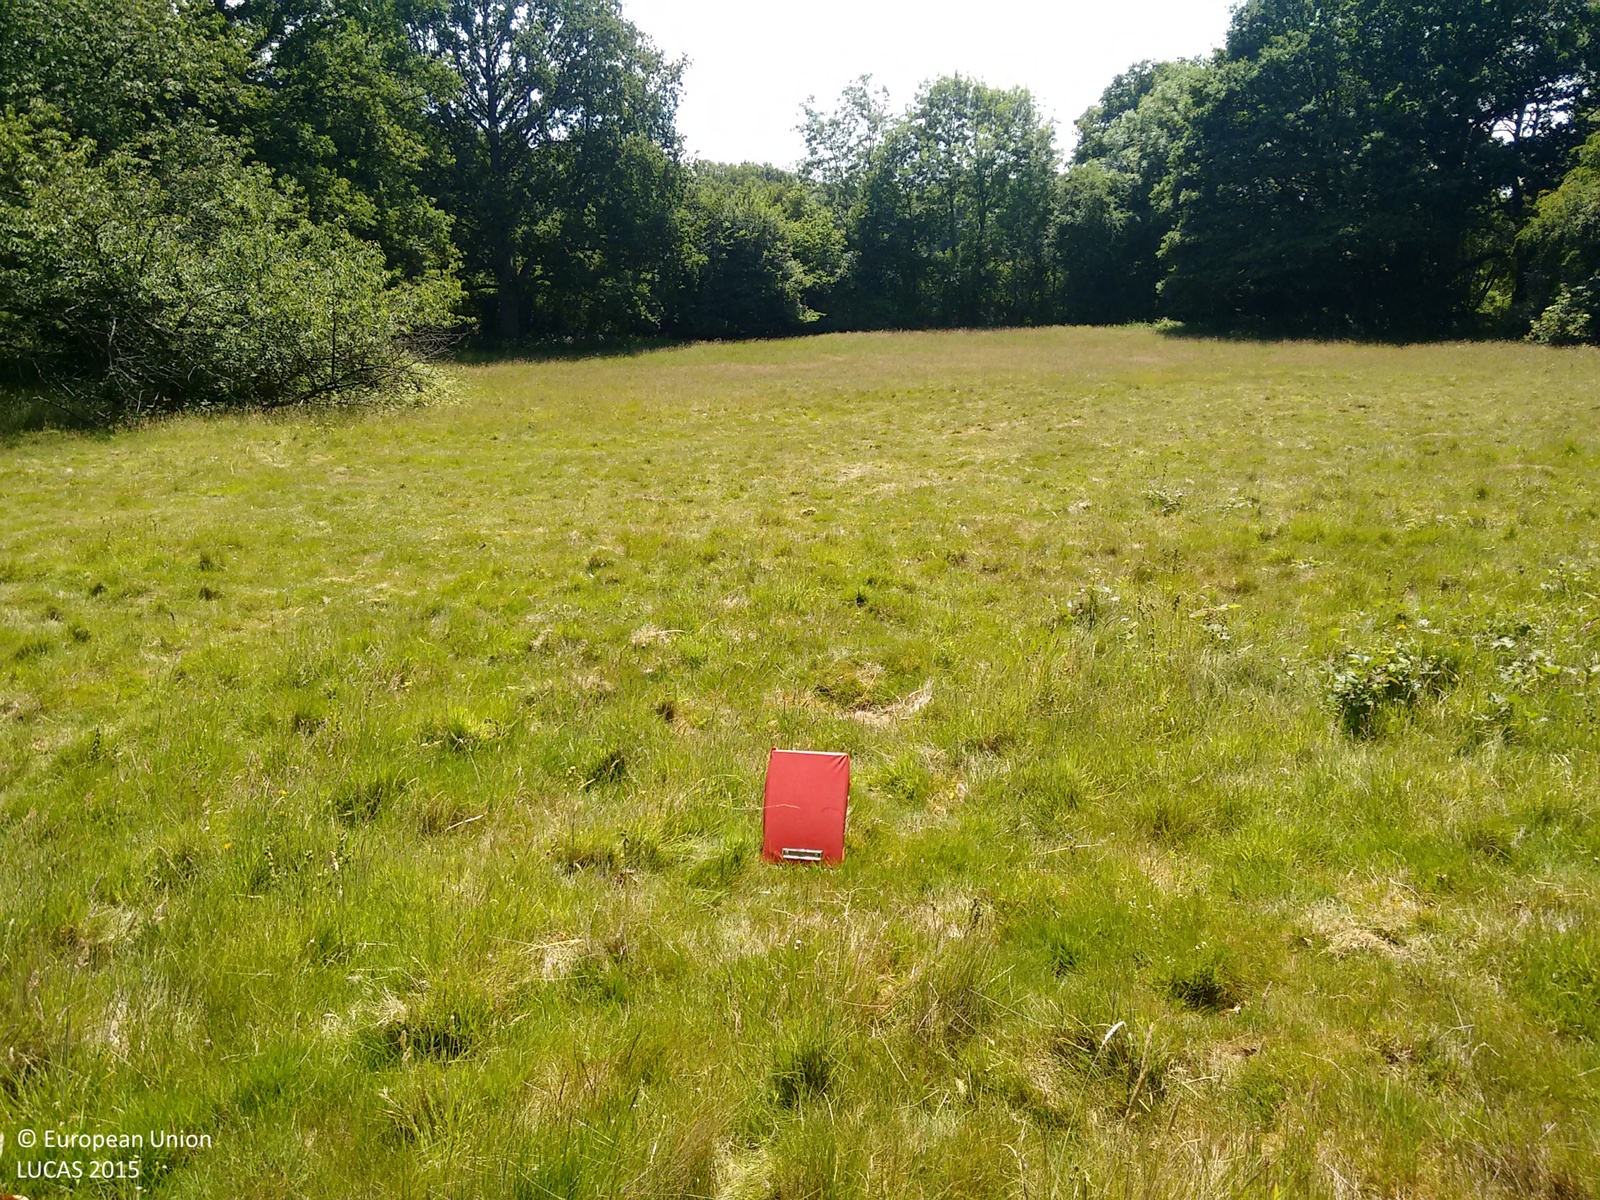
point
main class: Grassland
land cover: Grassland without tree/shrub cover
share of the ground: > 75 %
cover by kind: herbaceous plants 100 %
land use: Semi-natural and natural areas not in use
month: June
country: GB
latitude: 51.2133
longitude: -0.1846
